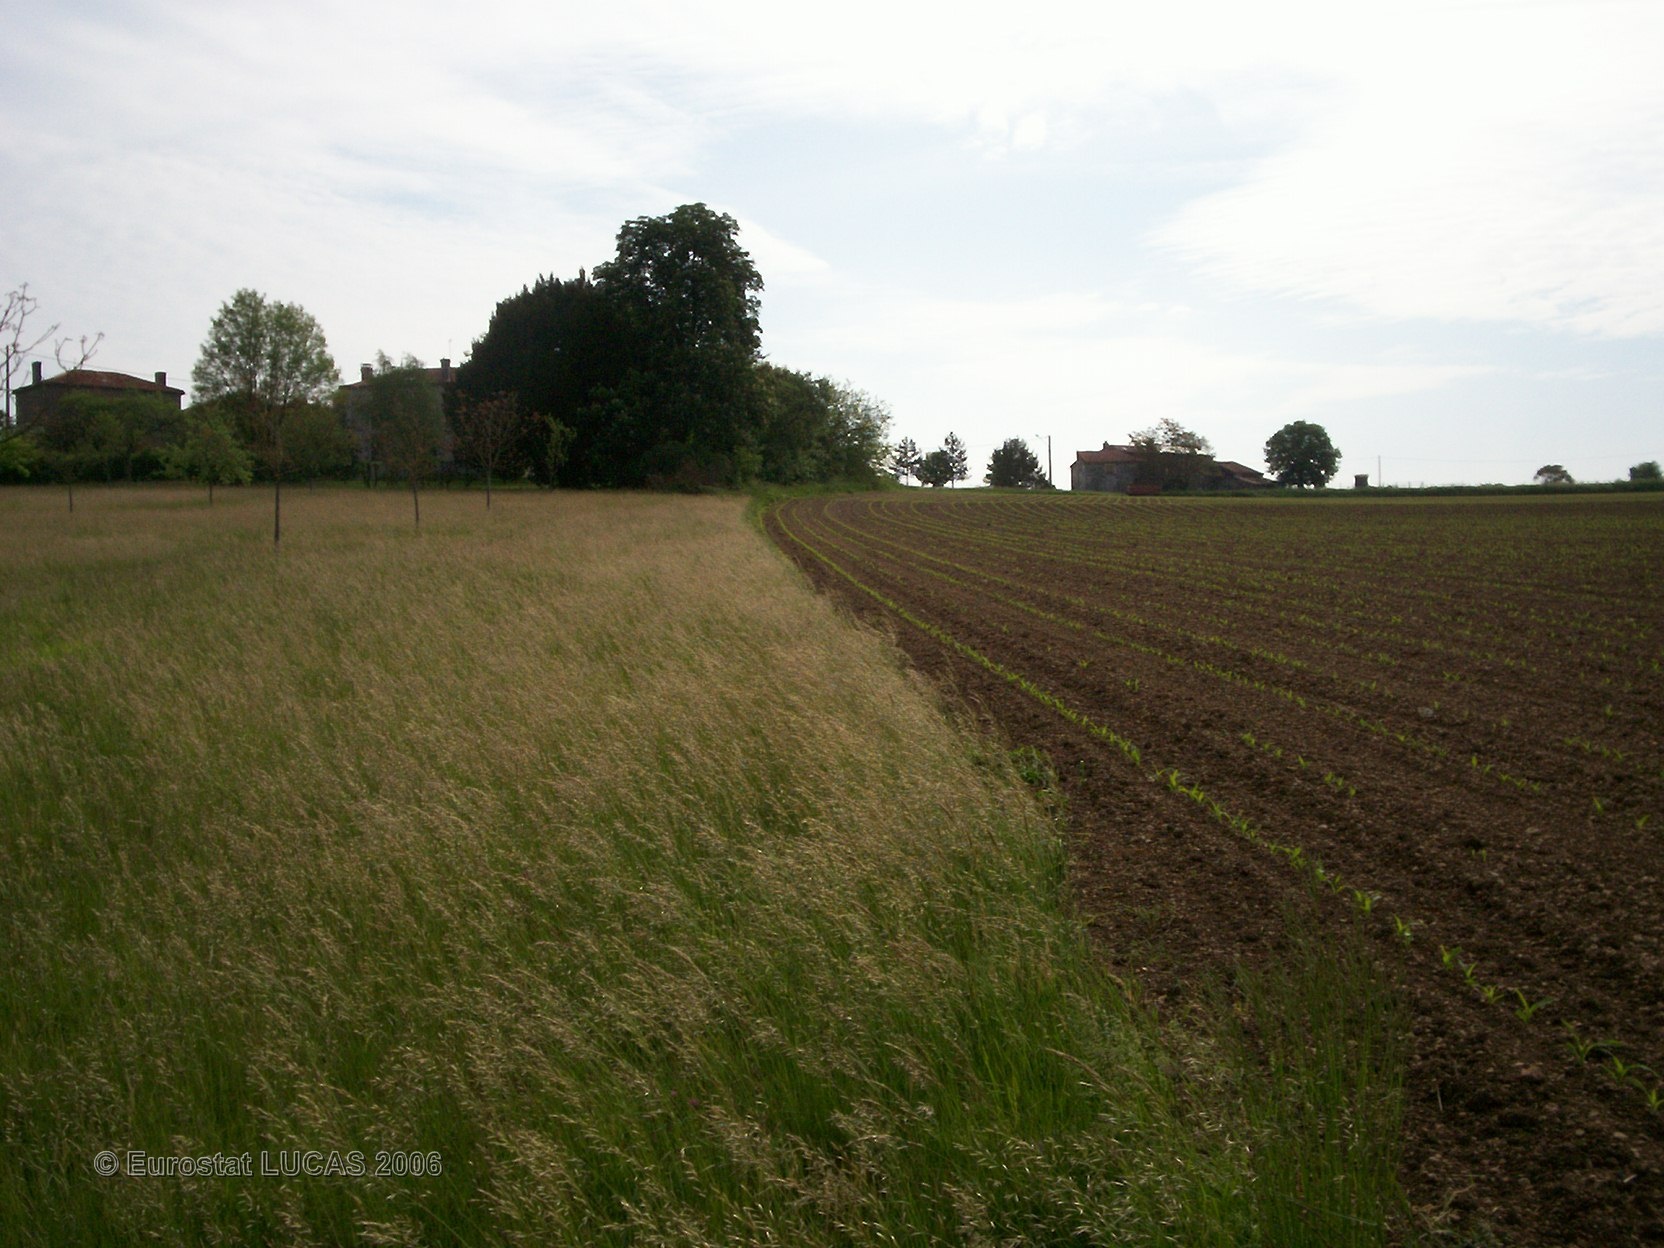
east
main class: Grassland
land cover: Grassland with sparse tree/shrub cover
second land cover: Nuts trees
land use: Agriculture (excluding fallow land and kitchen gardens)
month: May
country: FR
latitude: 45.4951
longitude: 0.5306
